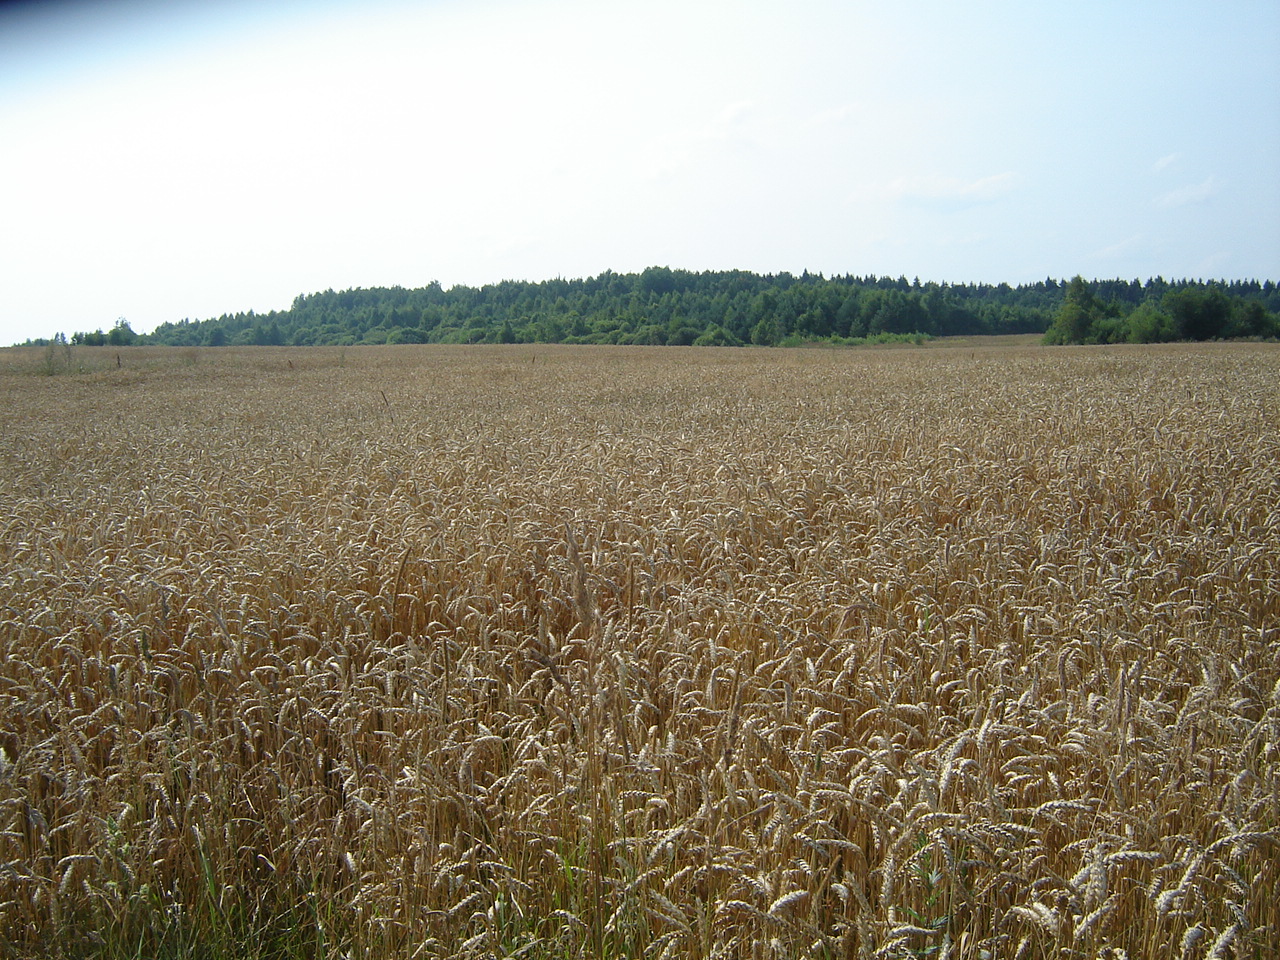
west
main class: Cropland
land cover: Common wheat
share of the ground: > 75 %
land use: Agriculture (excluding fallow land and kitchen gardens)
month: August
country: LT
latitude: 54.9614
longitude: 25.0615
